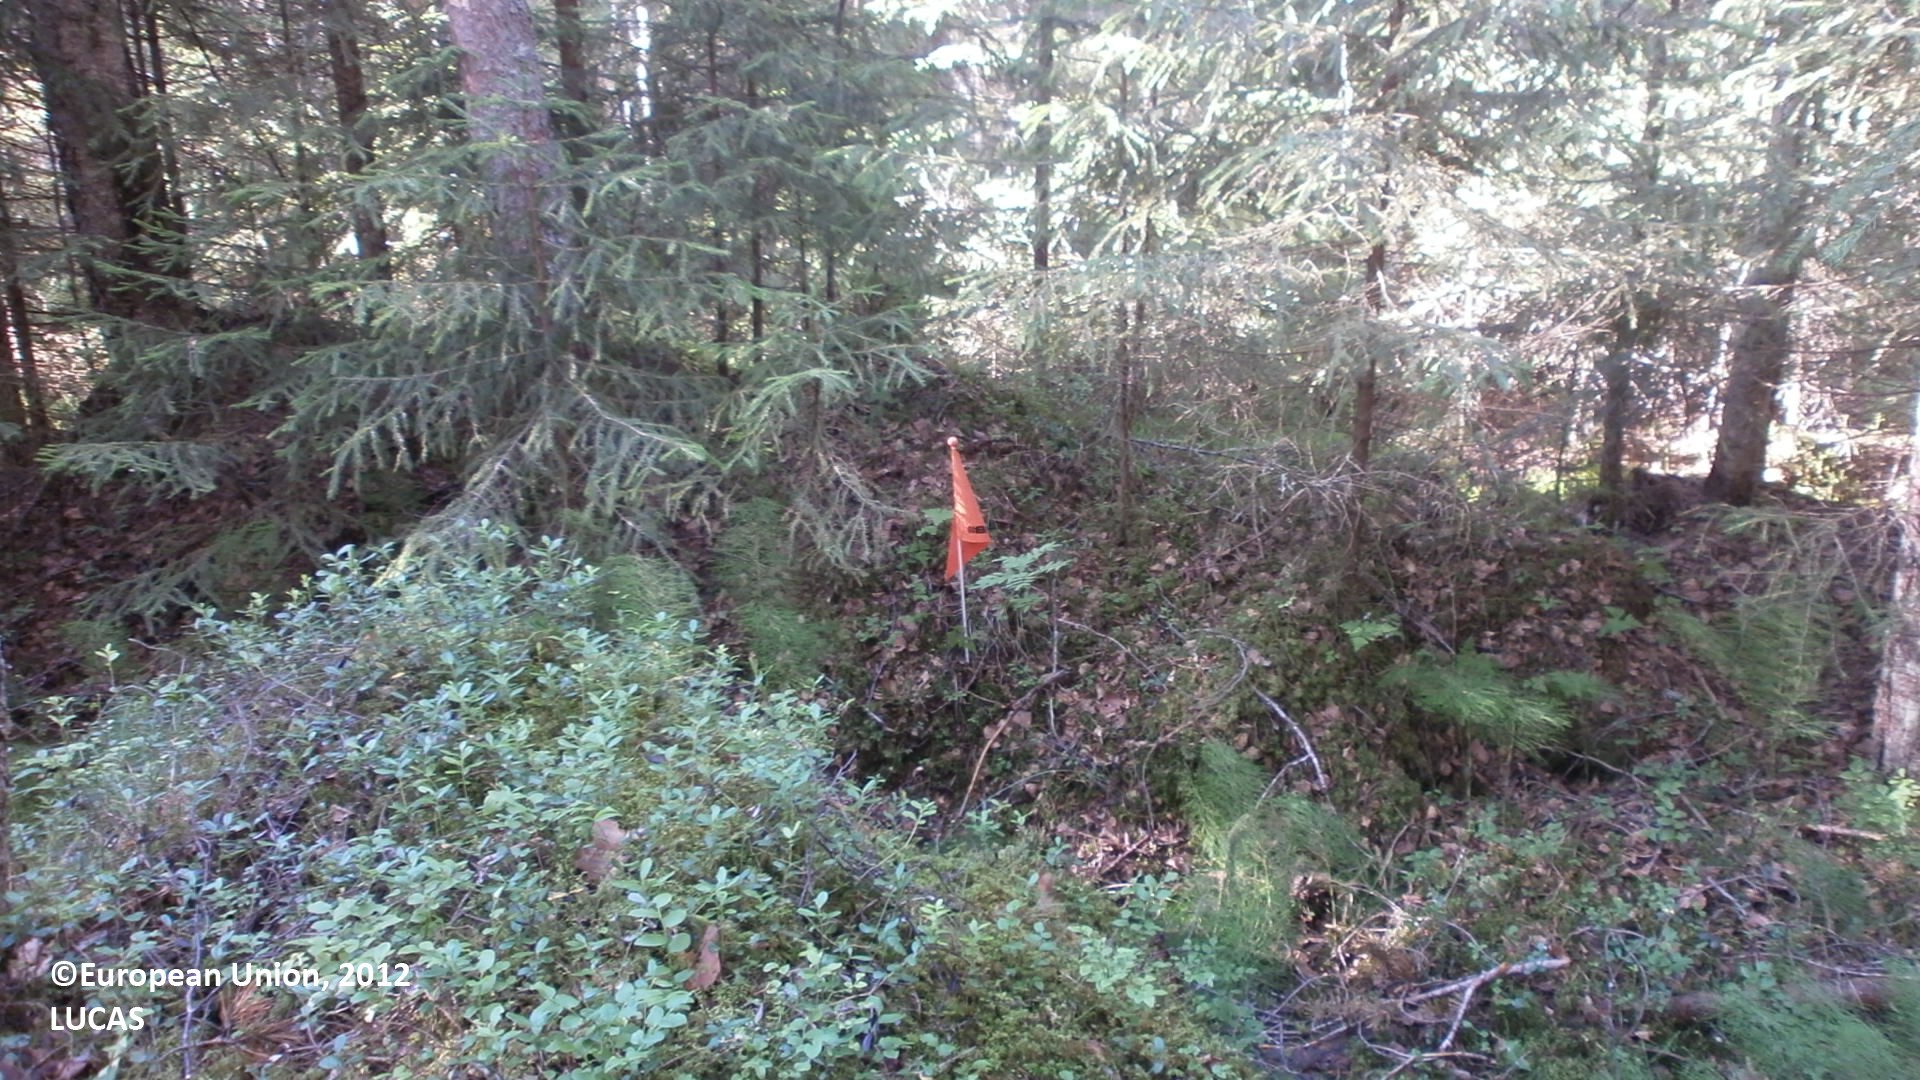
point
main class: Woodland
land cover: Spruce dominated mixed woodland
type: boreal forest
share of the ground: > 75 %
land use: Forestry
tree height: > 5 m
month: July
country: FI
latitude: 64.1541
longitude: 24.0657
